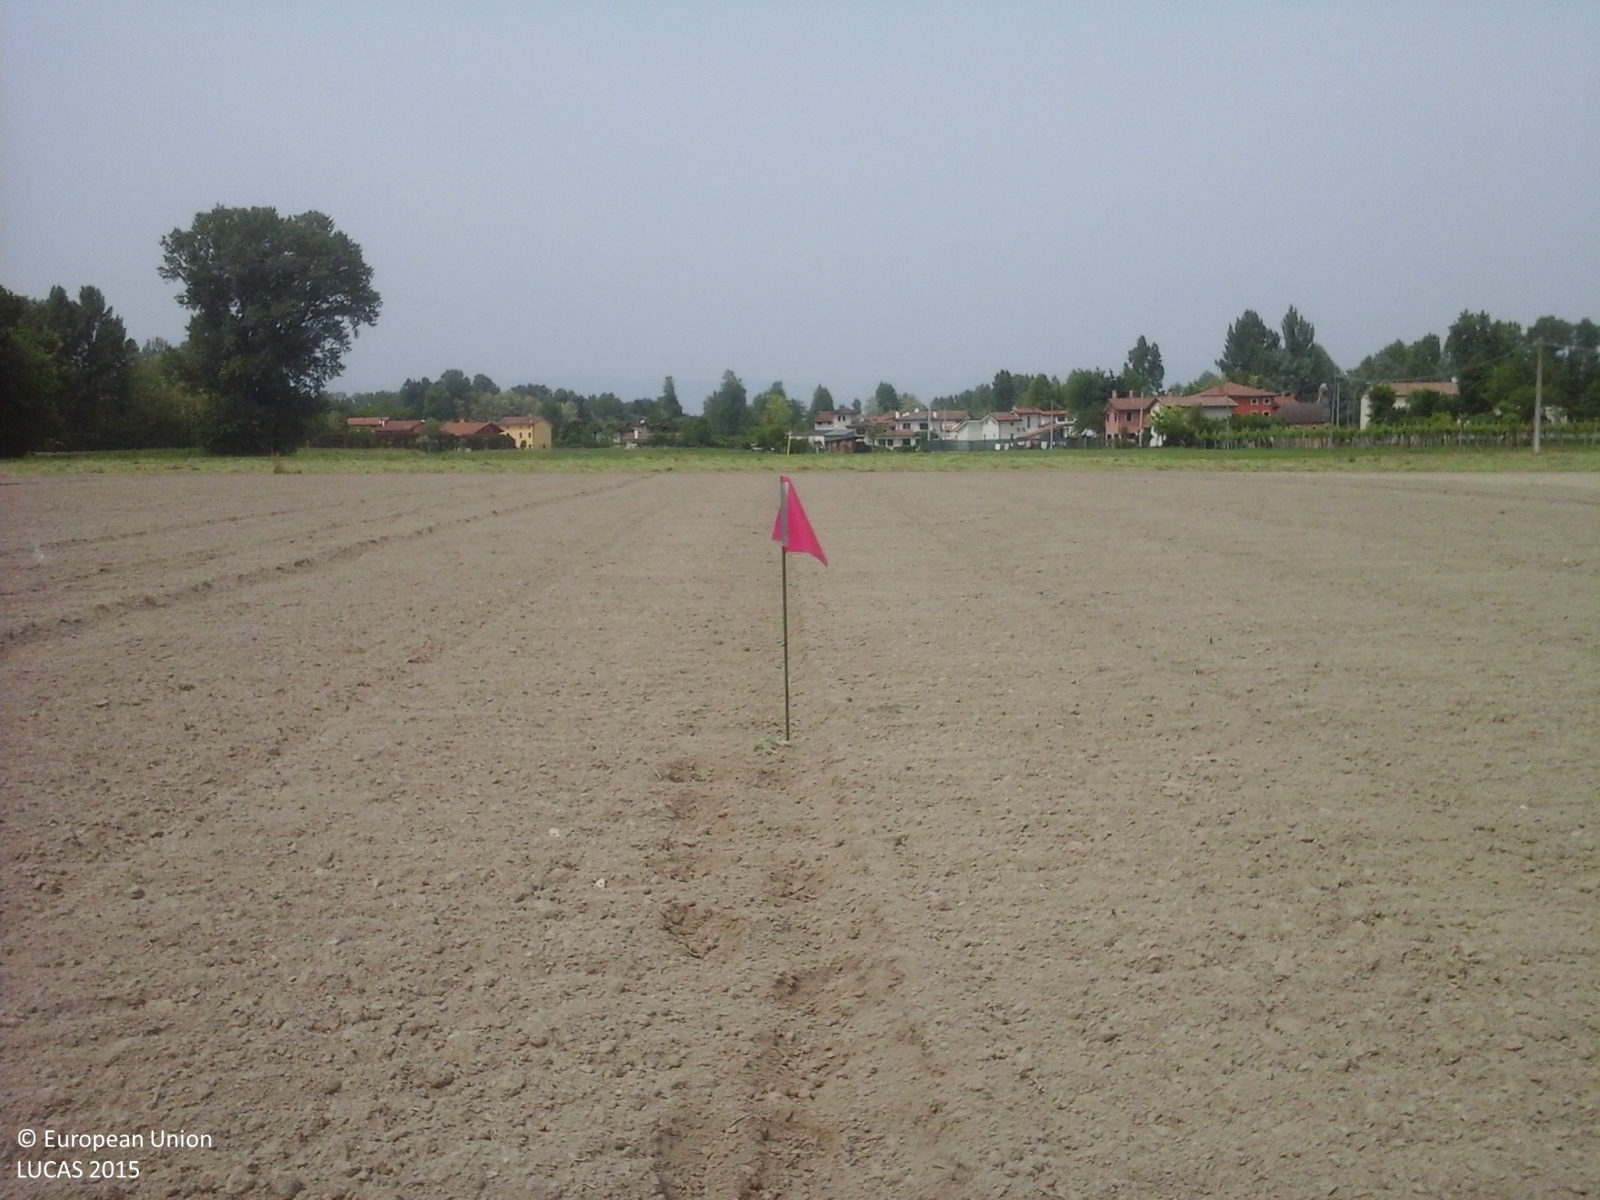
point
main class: Cropland
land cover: Other fresh vegetables
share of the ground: < 10 %
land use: Agriculture (excluding fallow land and kitchen gardens)
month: May
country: IT
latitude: 45.6160
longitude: 11.7541
